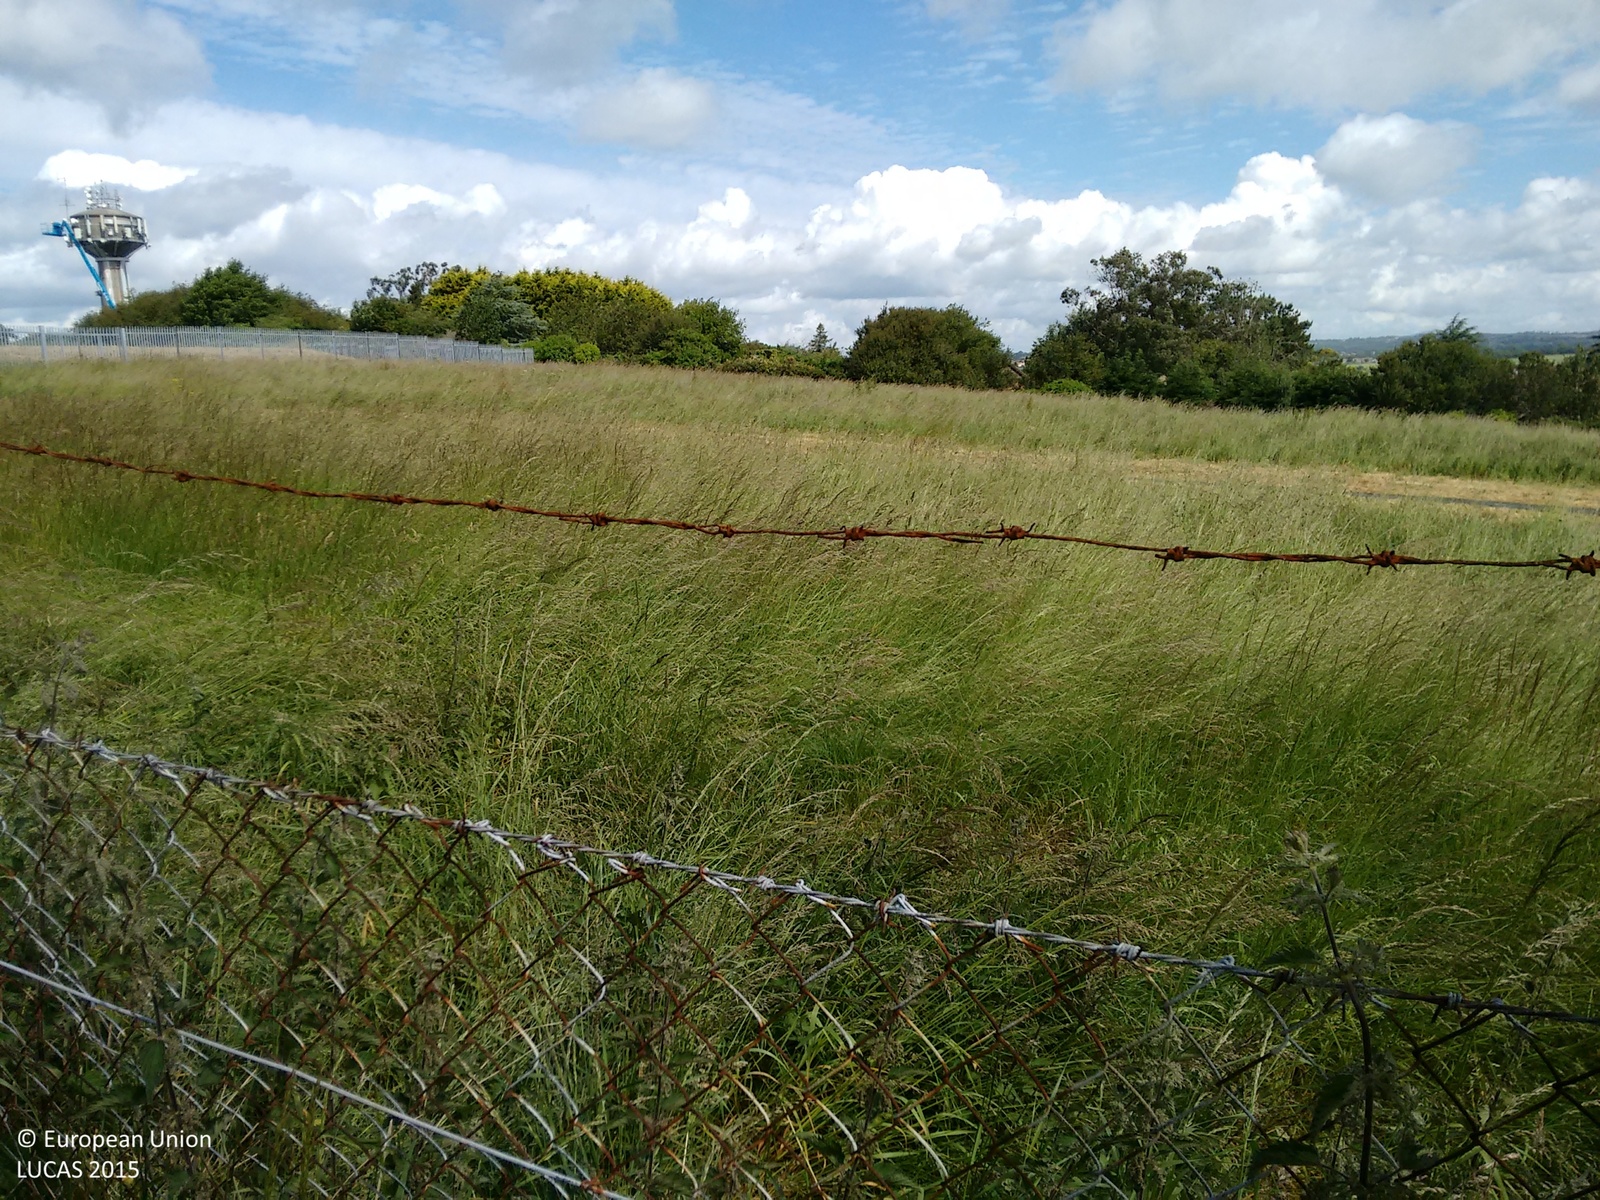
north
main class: Grassland
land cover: Grassland without tree/shrub cover
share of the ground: > 75 %
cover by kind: herbaceous plants 100 %
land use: Semi-natural and natural areas not in use
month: June
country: IE
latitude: 52.2468
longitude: -7.0921
